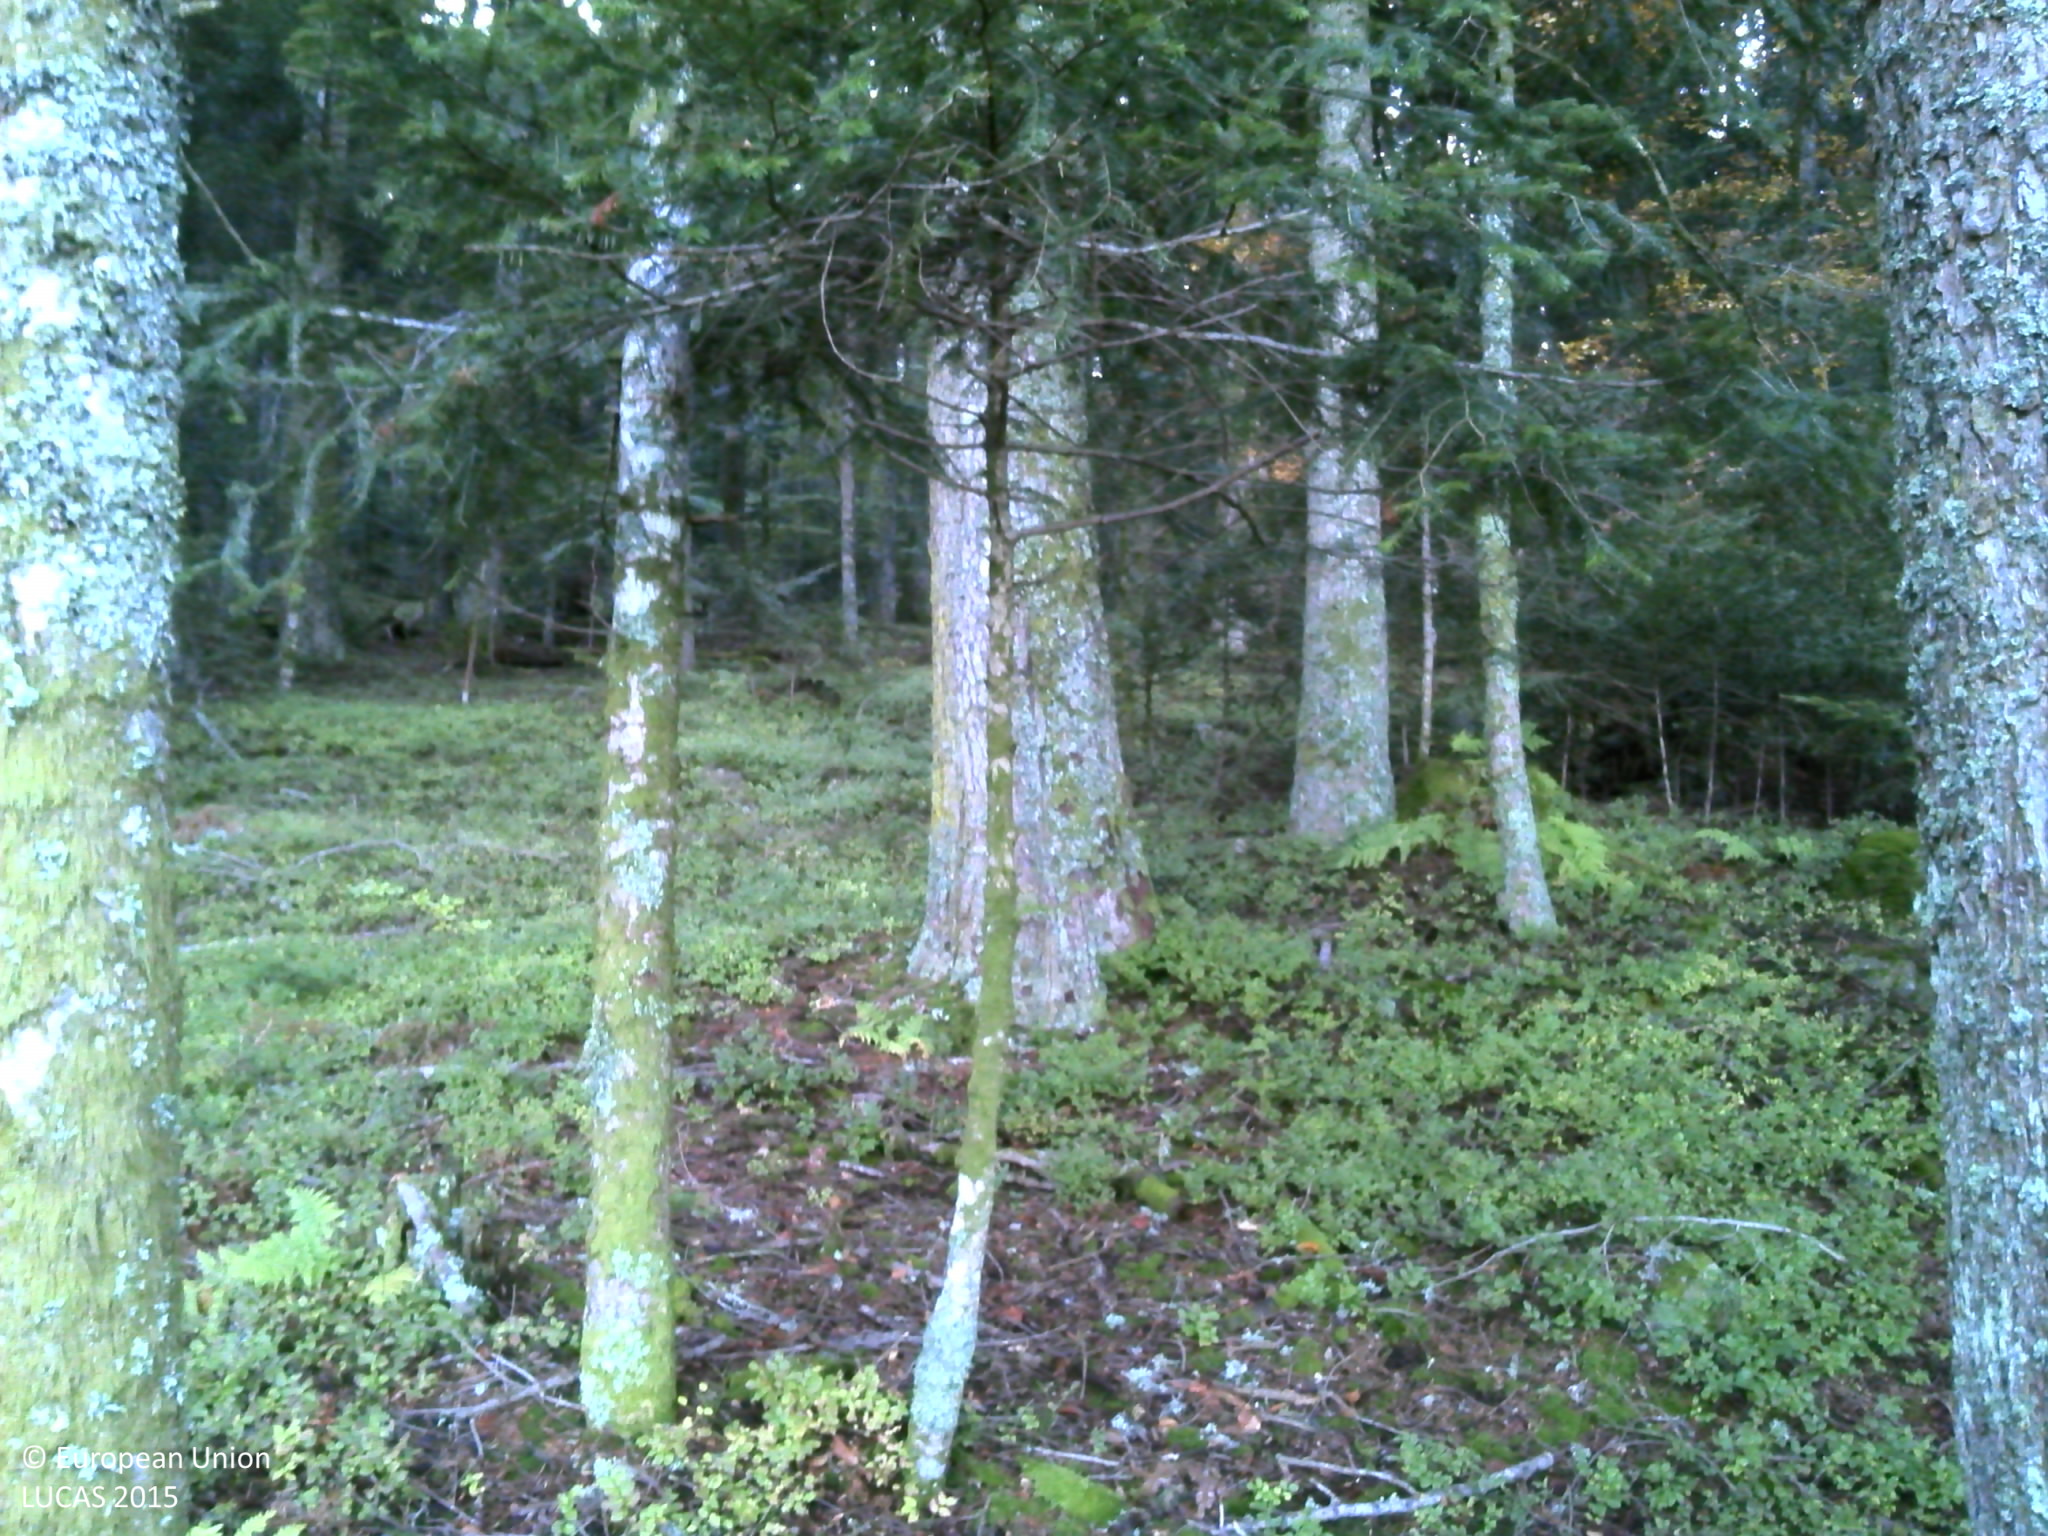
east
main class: Woodland
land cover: Other coniferous woodland
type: exotic forest
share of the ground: > 75 %
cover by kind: coniferous forest trees 85 %, broadleaved forest trees 5 %, herbaceous plants 5 %, lichens and mosses 5 %
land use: Forestry
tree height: > 5 m
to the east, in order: Other coniferous woodland; Other mixed woodland
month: October
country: FR
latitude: 45.7344
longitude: 3.7432
